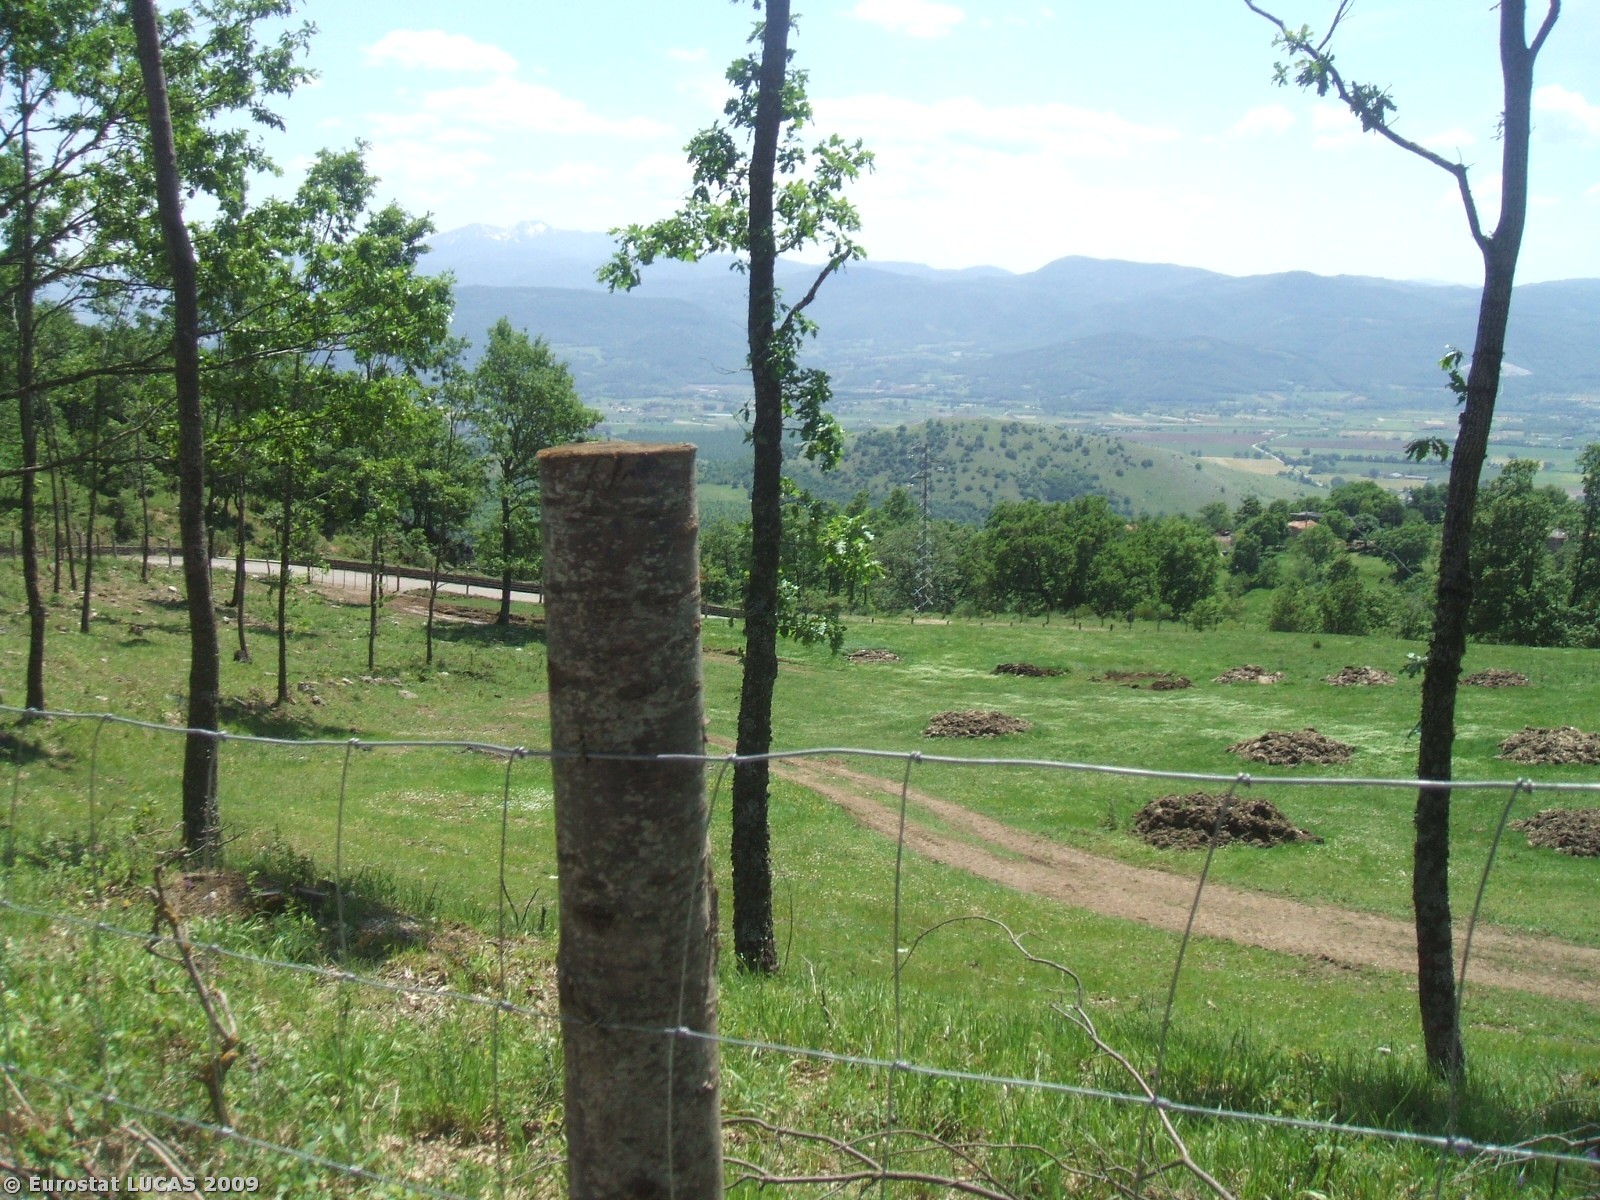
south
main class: Woodland
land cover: Broadleaved woodland
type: thermophilous deciduous forest
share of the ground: > 75 %
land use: Forestry
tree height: > 5 m
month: May
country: IT
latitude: 40.3633
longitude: 15.8758
